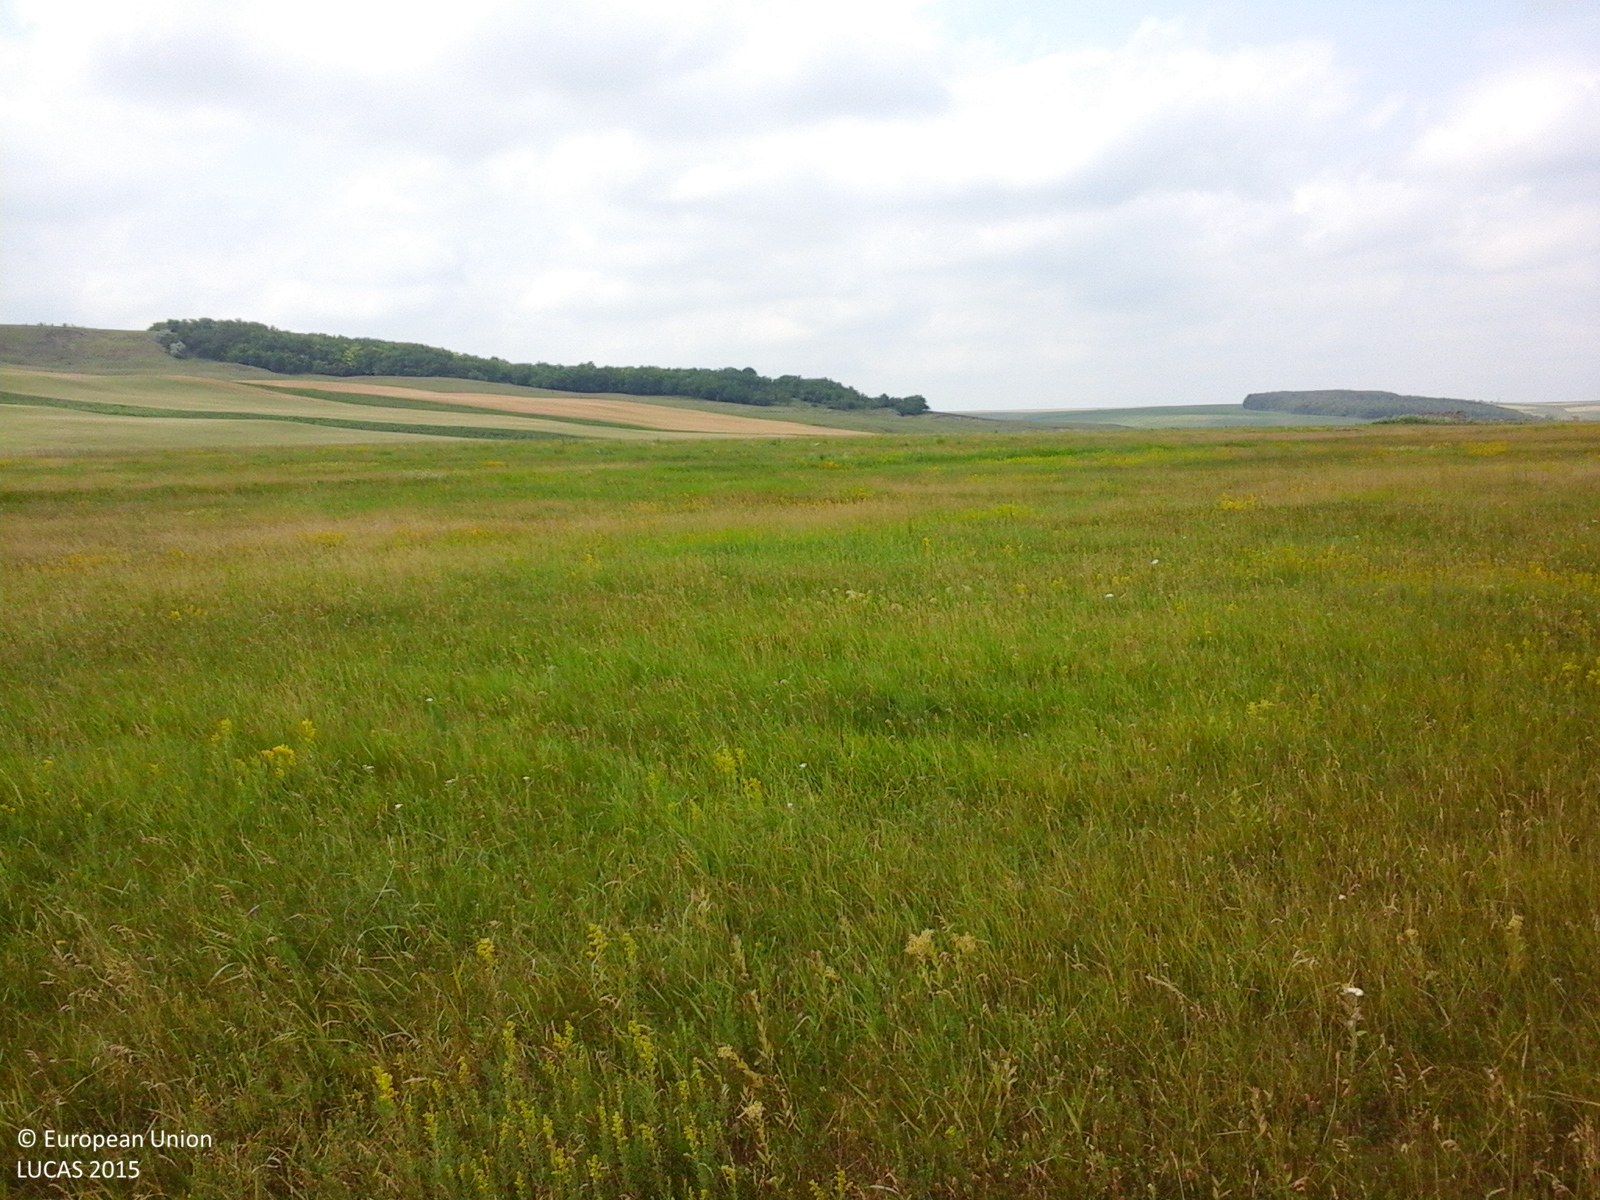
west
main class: Grassland
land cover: Grassland without tree/shrub cover
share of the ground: > 75 %
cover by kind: herbaceous plants 100 %
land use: Agriculture (excluding fallow land and kitchen gardens)
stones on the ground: < 10 %
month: June
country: RO
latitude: 48.0362
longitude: 26.6053
